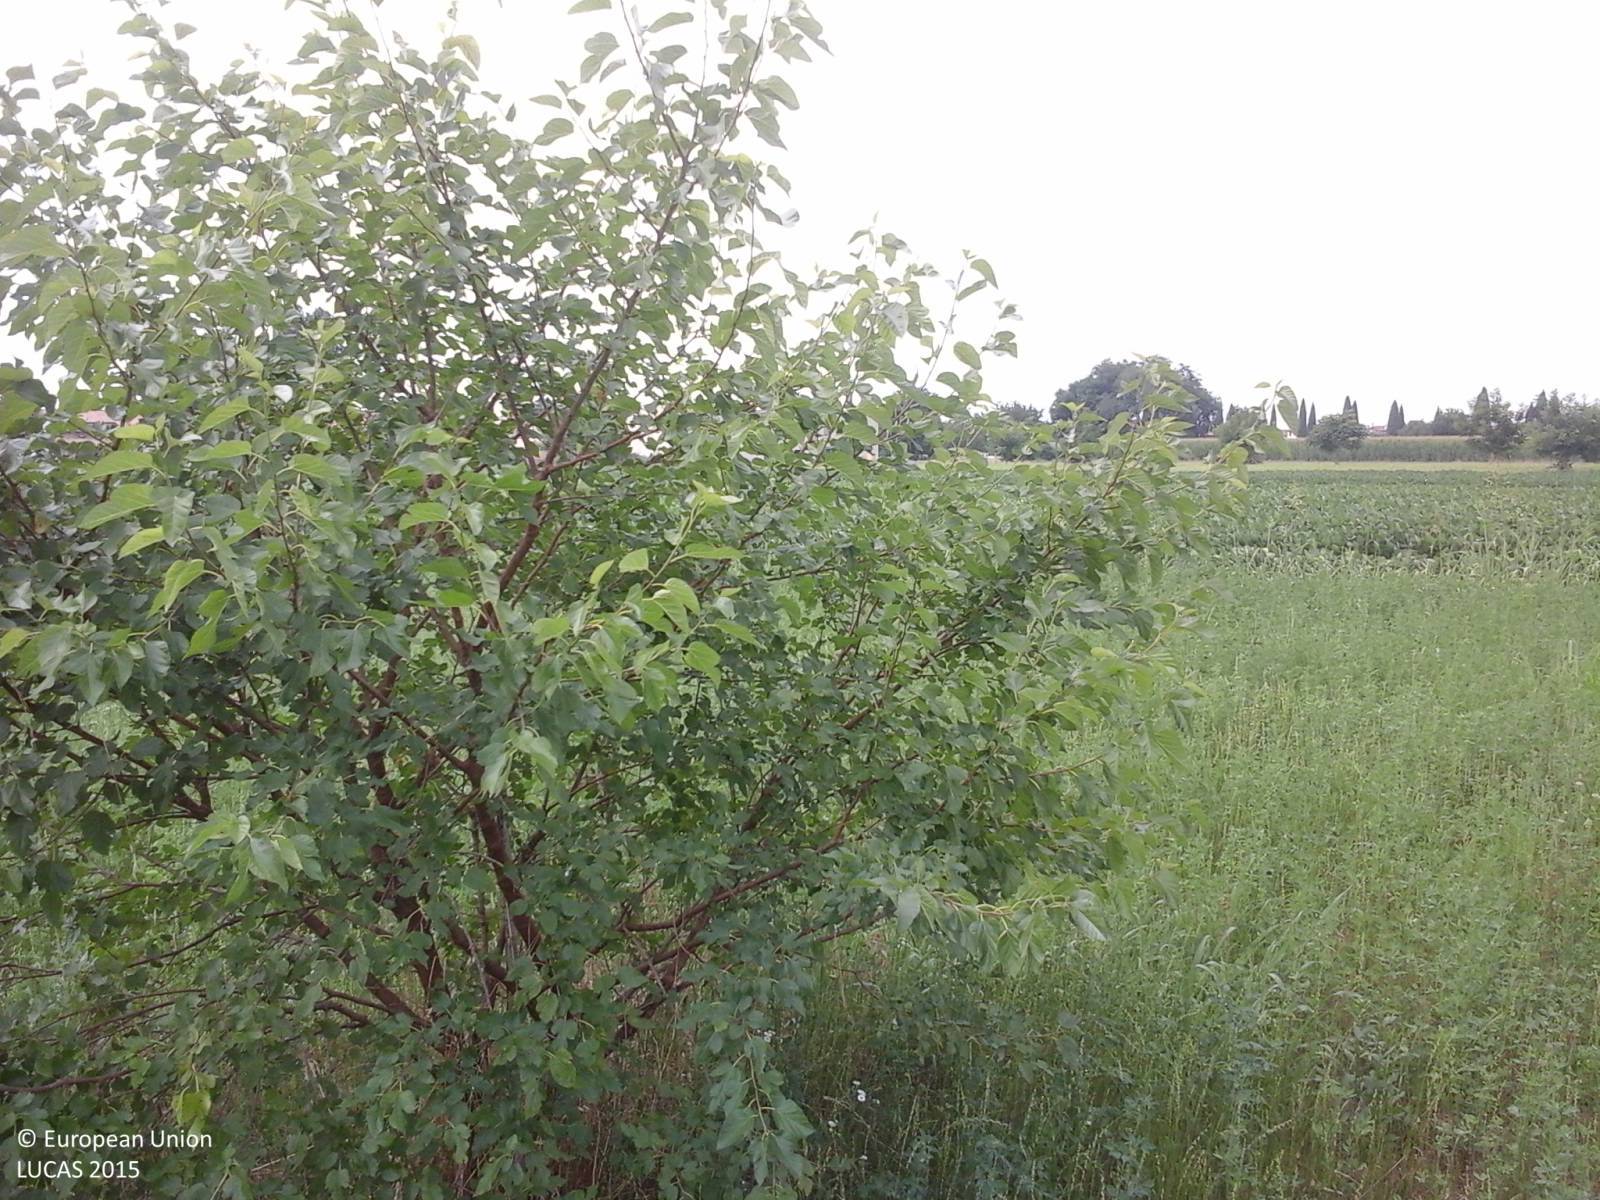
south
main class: Cropland
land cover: Lucerne
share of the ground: > 75 %
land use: Agriculture (excluding fallow land and kitchen gardens)
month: July
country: IT
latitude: 45.9471
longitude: 13.0537
